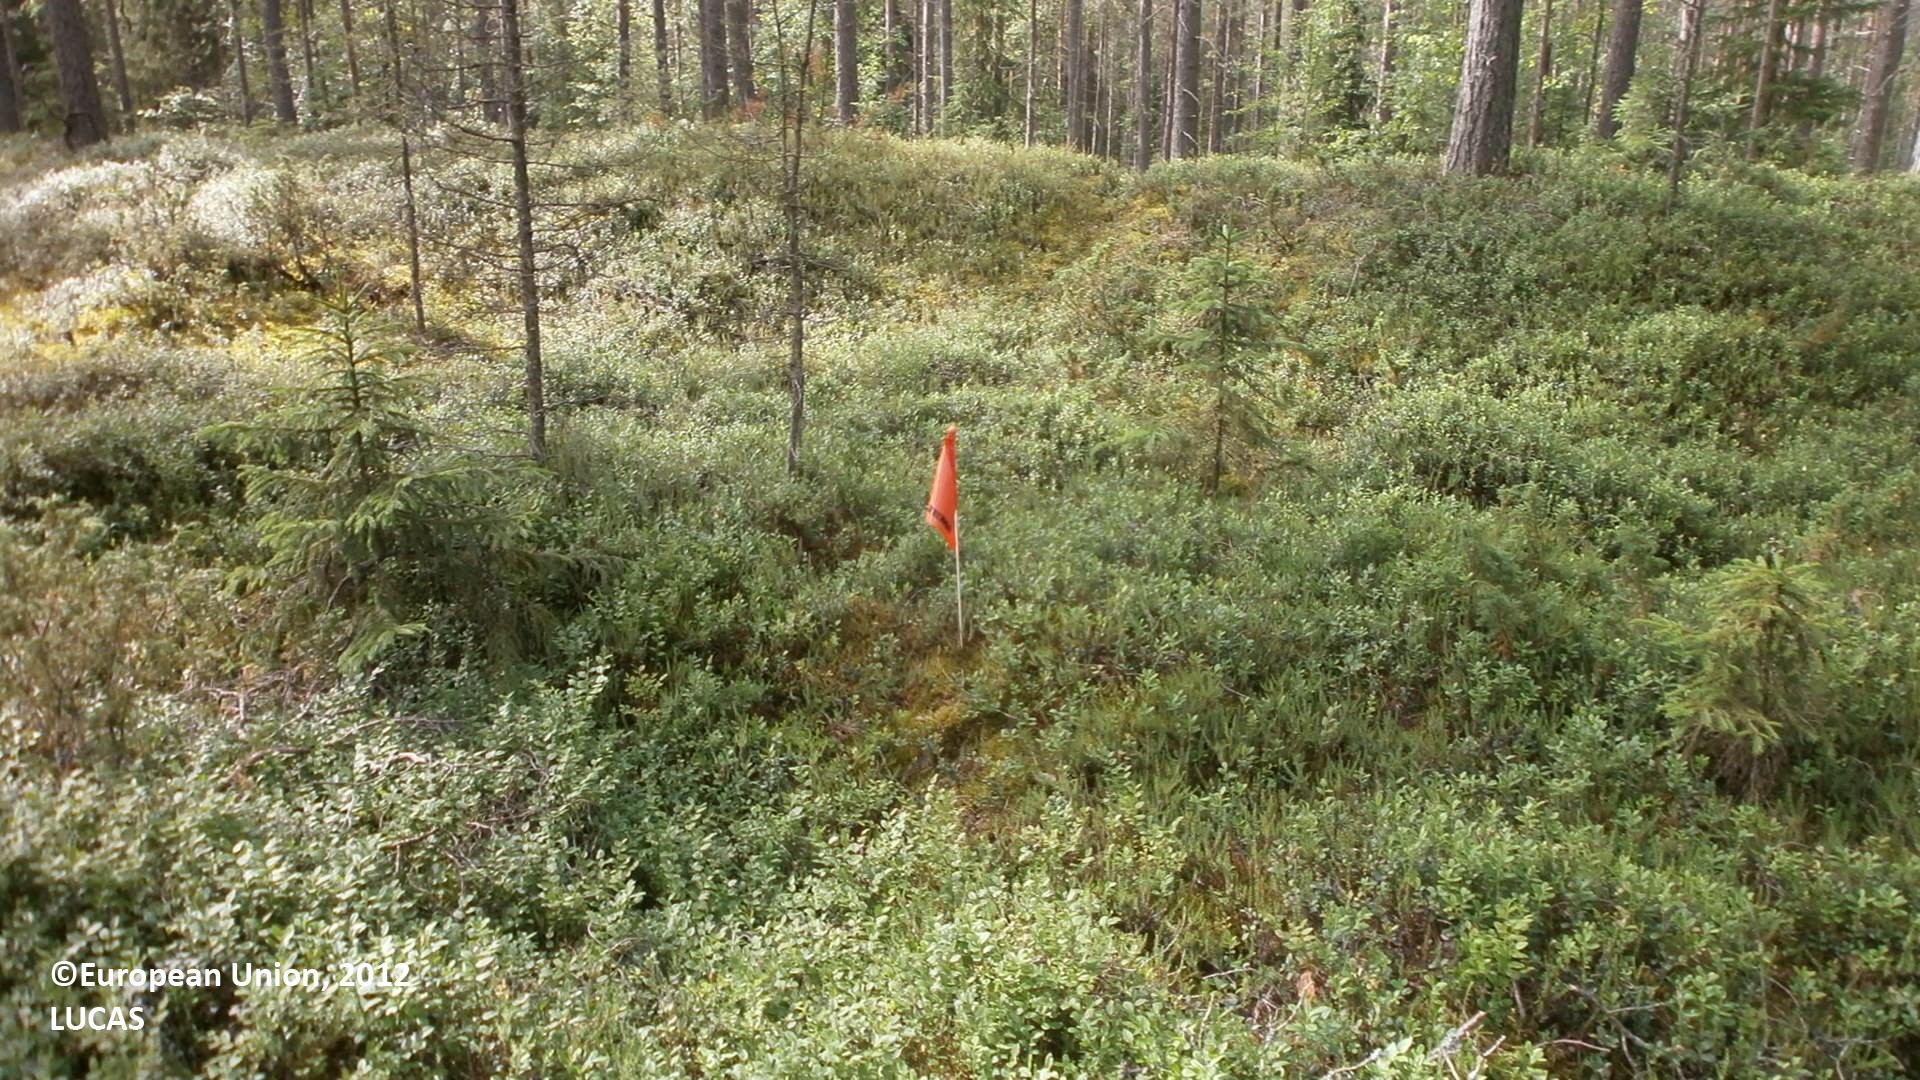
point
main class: Woodland
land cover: Pine dominated coniferous woodland
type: boreal forest
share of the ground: 50 - 75 %
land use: Forestry
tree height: > 5 m
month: July
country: FI
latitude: 64.2461
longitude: 23.8601
